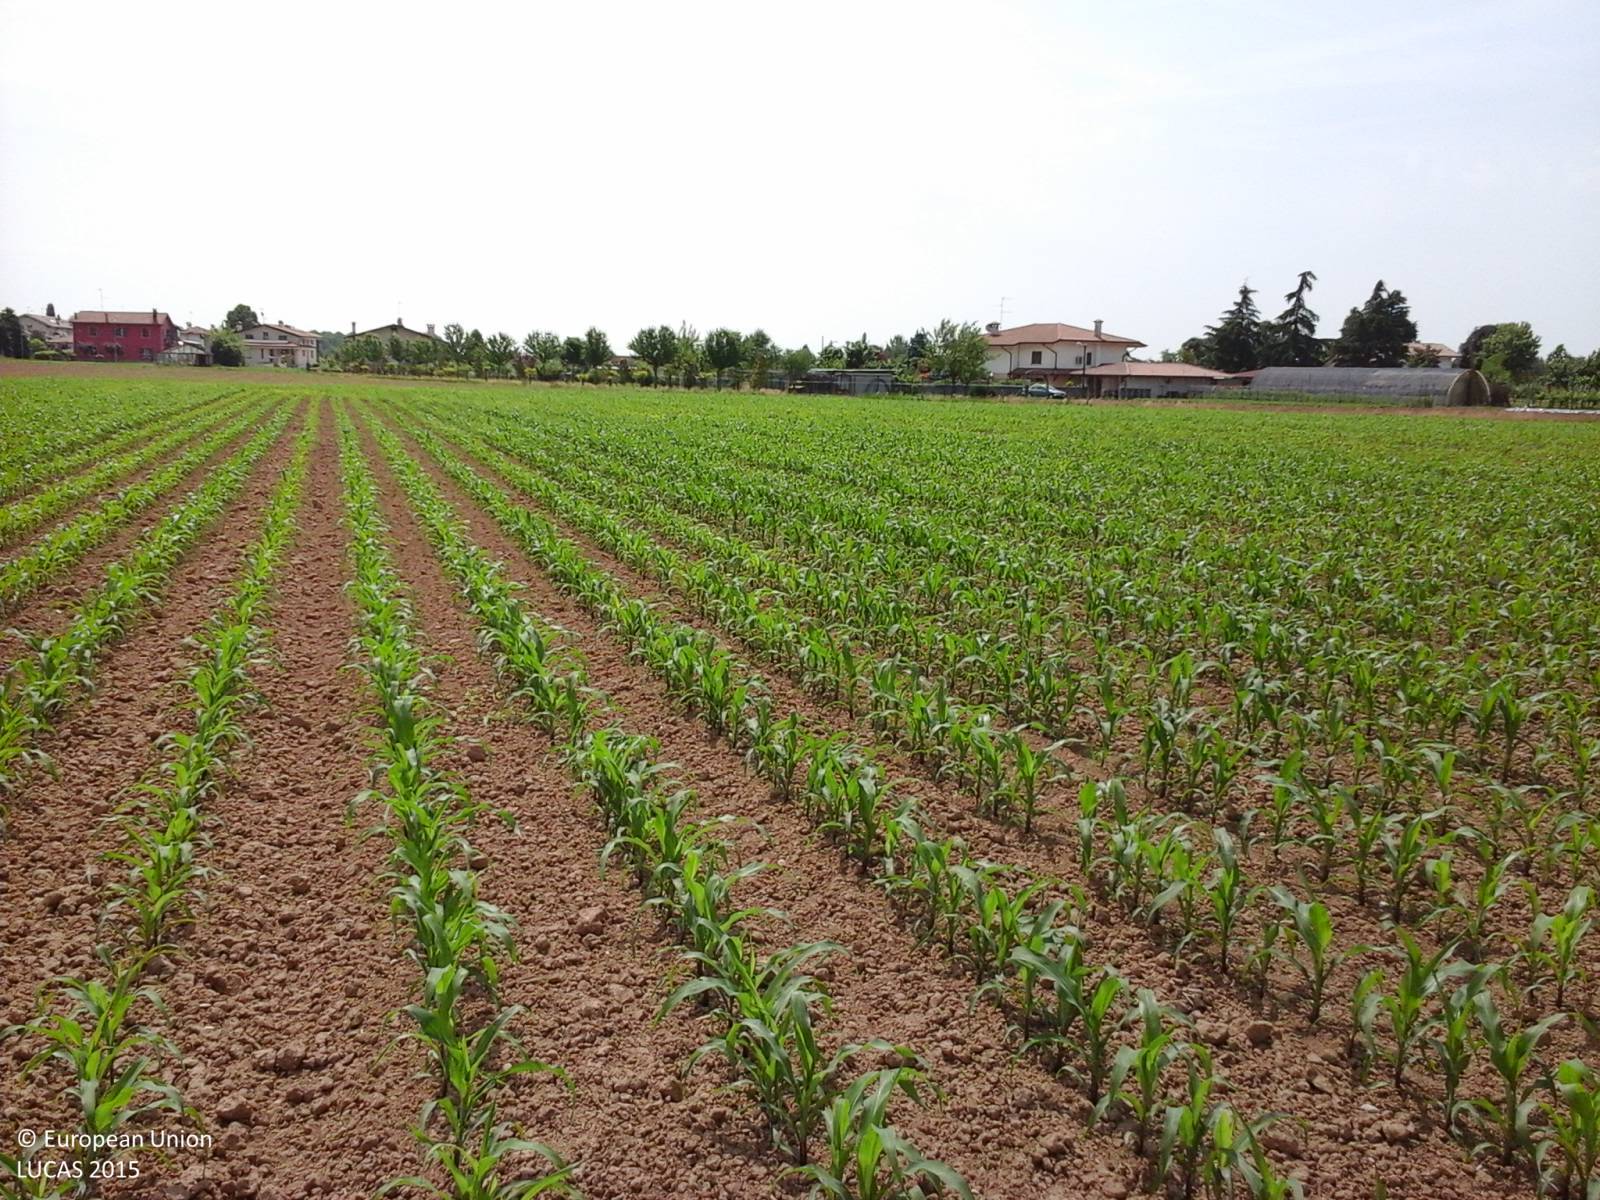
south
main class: Cropland
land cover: Maize
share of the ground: 25 - 50 %
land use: Agriculture (excluding fallow land and kitchen gardens)
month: May
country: IT
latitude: 45.9754
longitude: 13.3133
